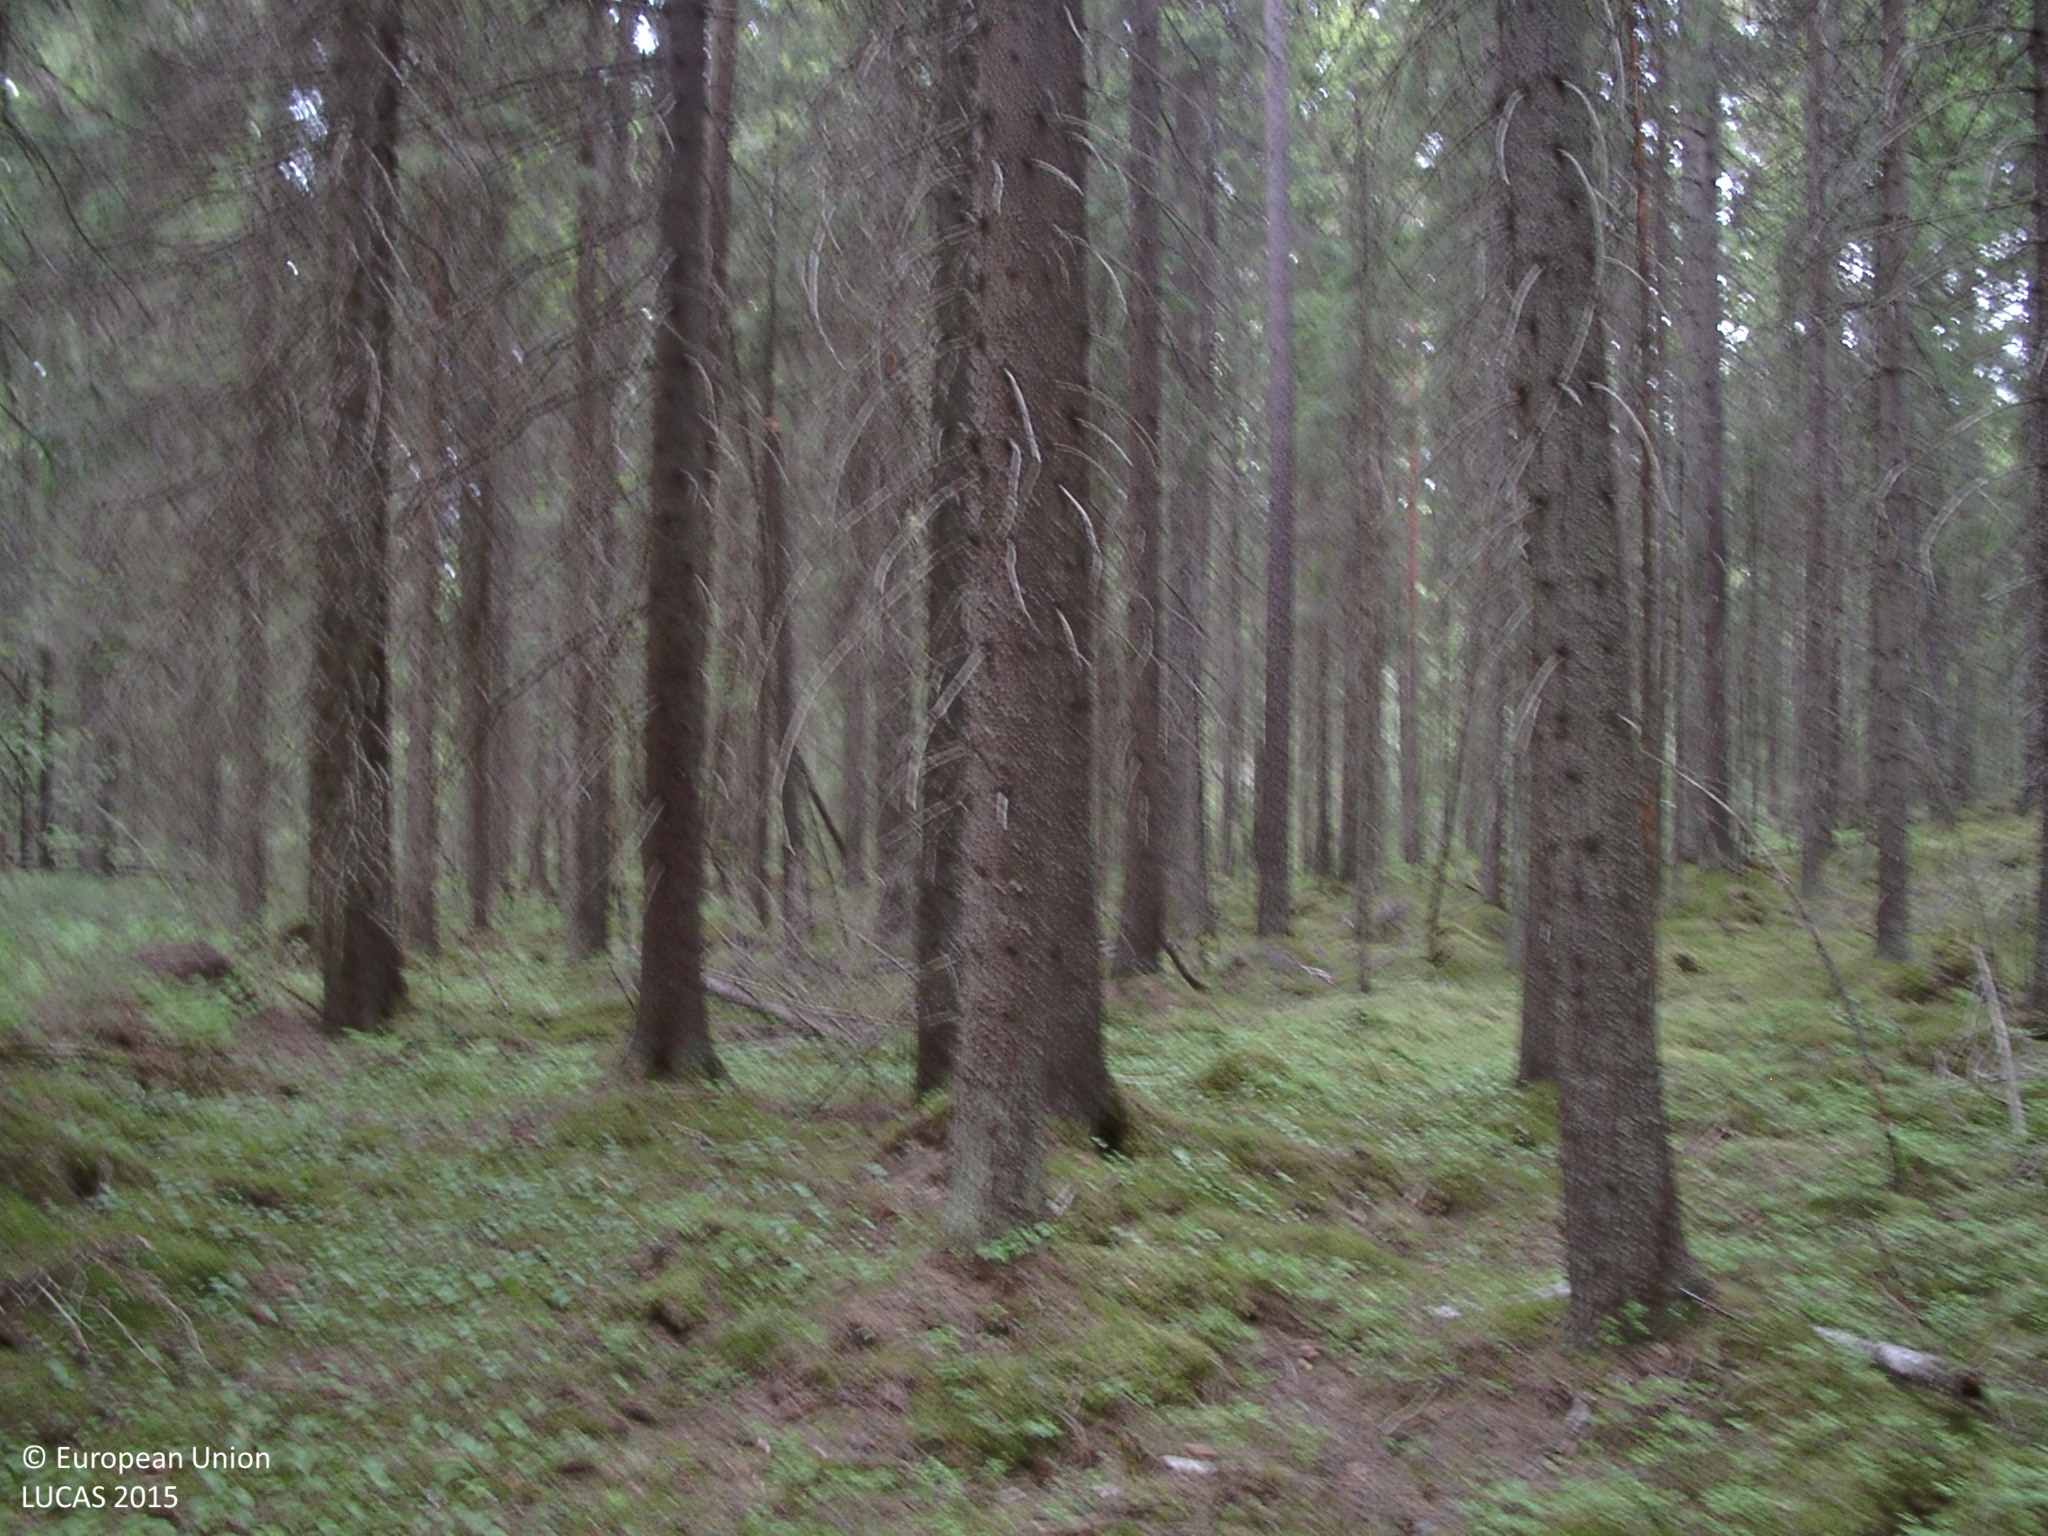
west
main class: Woodland
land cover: Spruce dominated coniferous woodland
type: boreal forest
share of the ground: 50 - 75 %
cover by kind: coniferous forest trees 65 %, lichens and mosses 15 %, shrubs 10 %, broadleaved forest trees 5 %, herbaceous plants 5 %
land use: Forestry
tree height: > 5 m
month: June
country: FI
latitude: 62.0723
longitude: 25.5627
